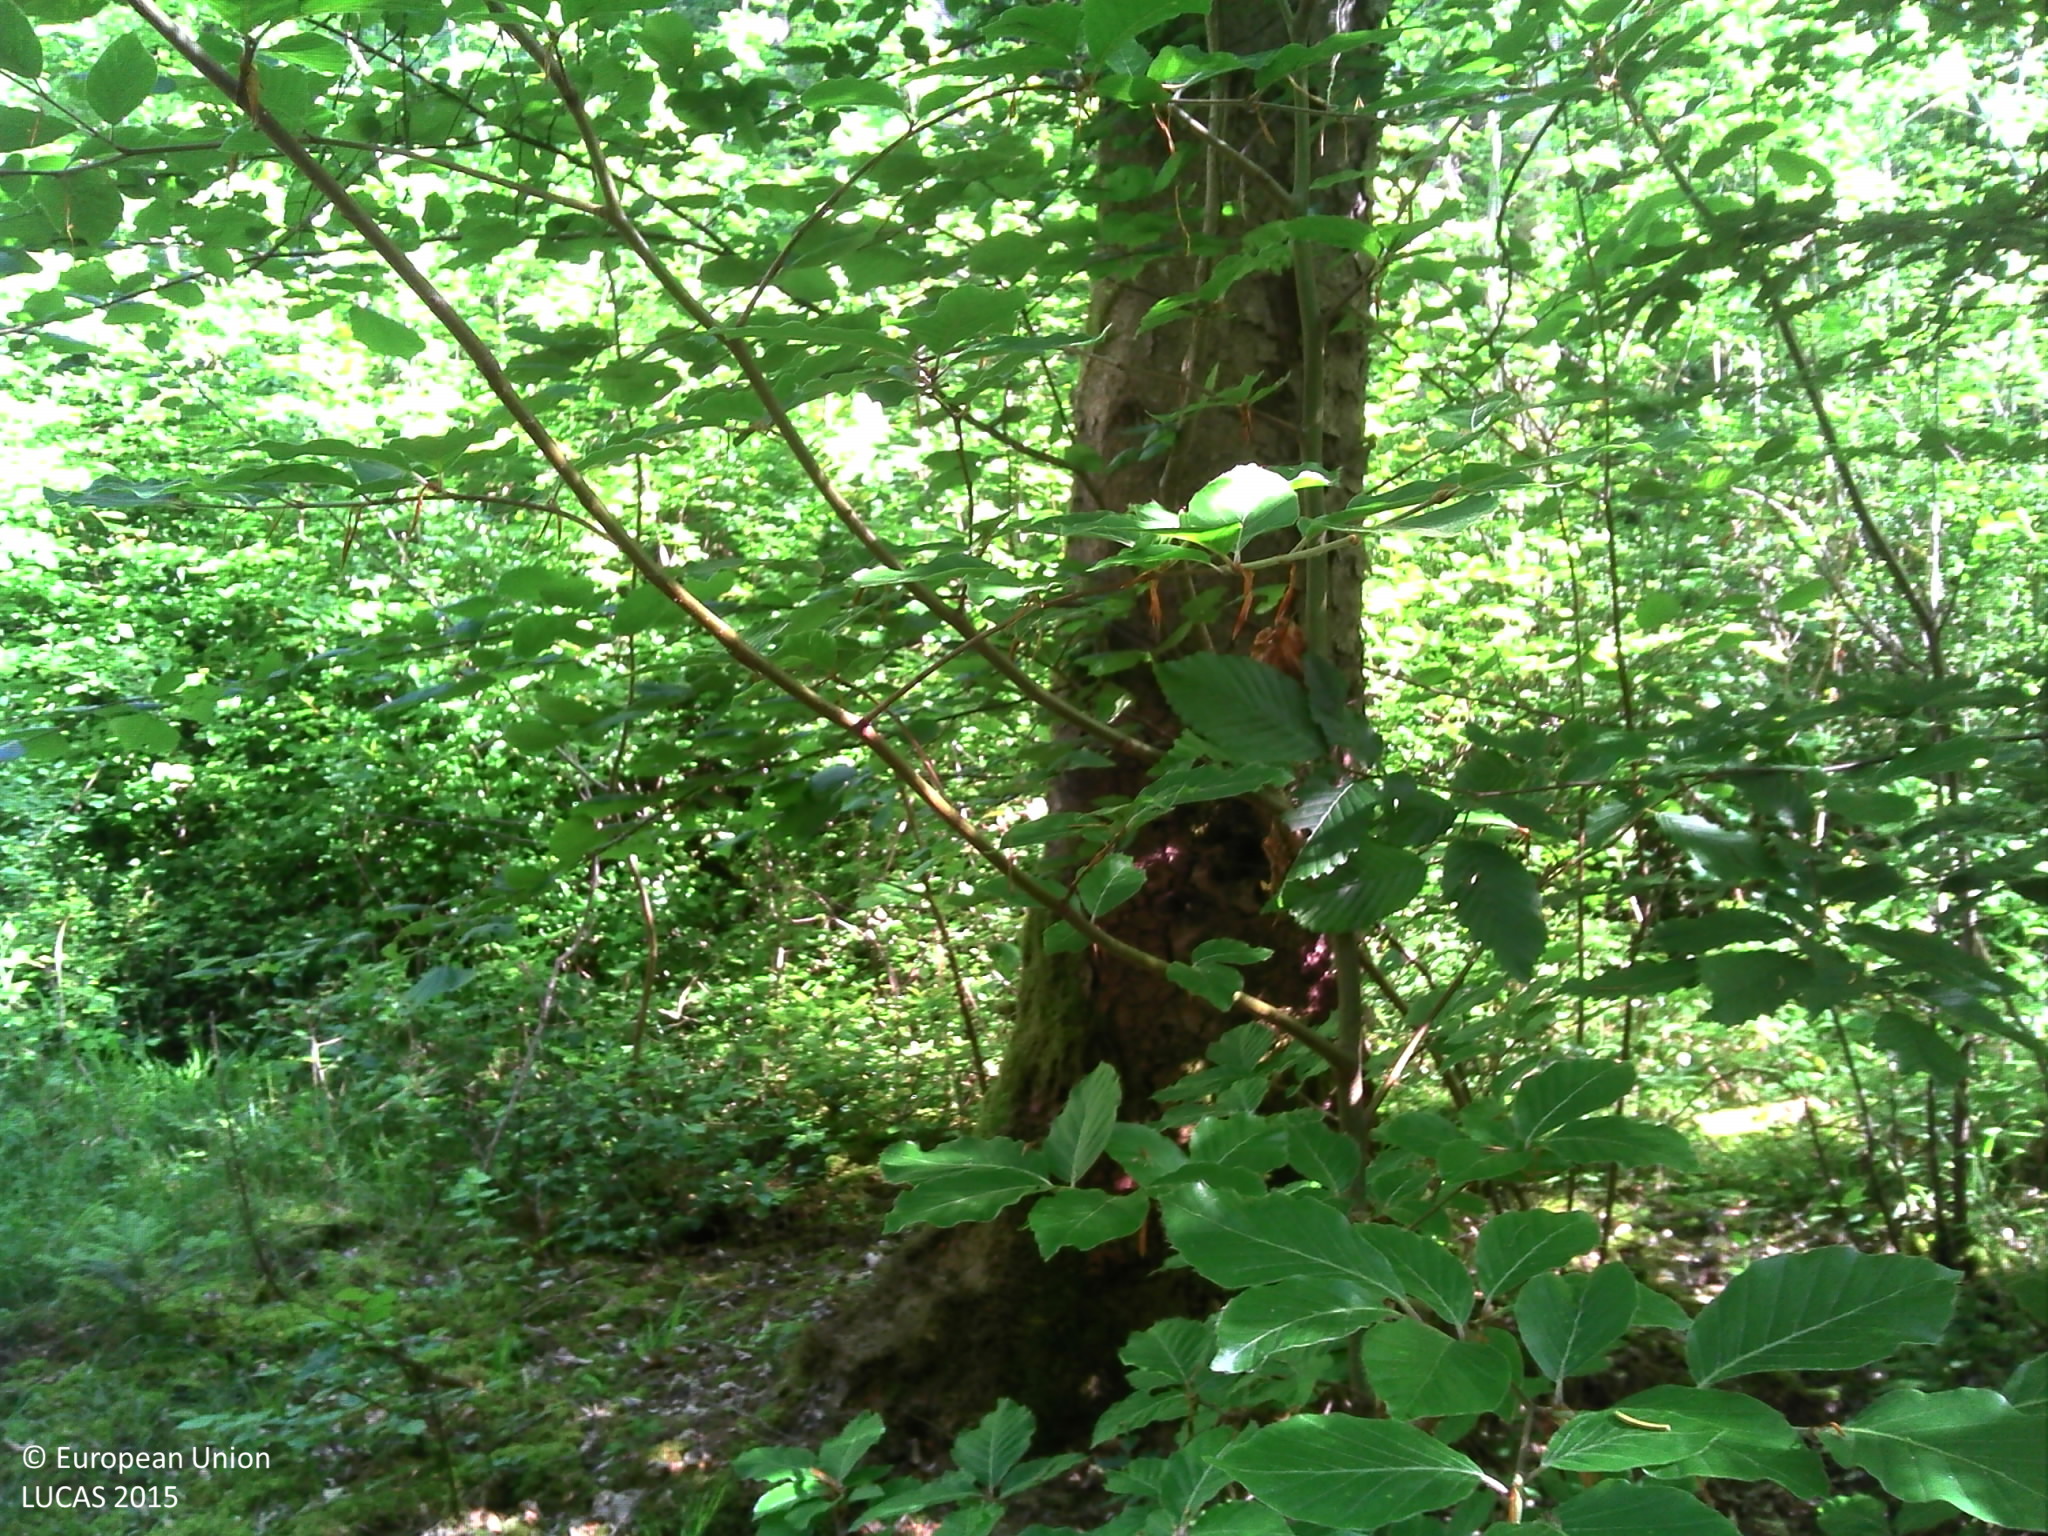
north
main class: Woodland
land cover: Spruce dominated mixed woodland
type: mesophytic deciduous forest
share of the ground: > 75 %
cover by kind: coniferous forest trees 45 %, broadleaved forest trees 45 %, herbaceous plants 10 %
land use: Forestry
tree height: > 5 m
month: June
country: FR
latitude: 47.7011
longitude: 6.0165
